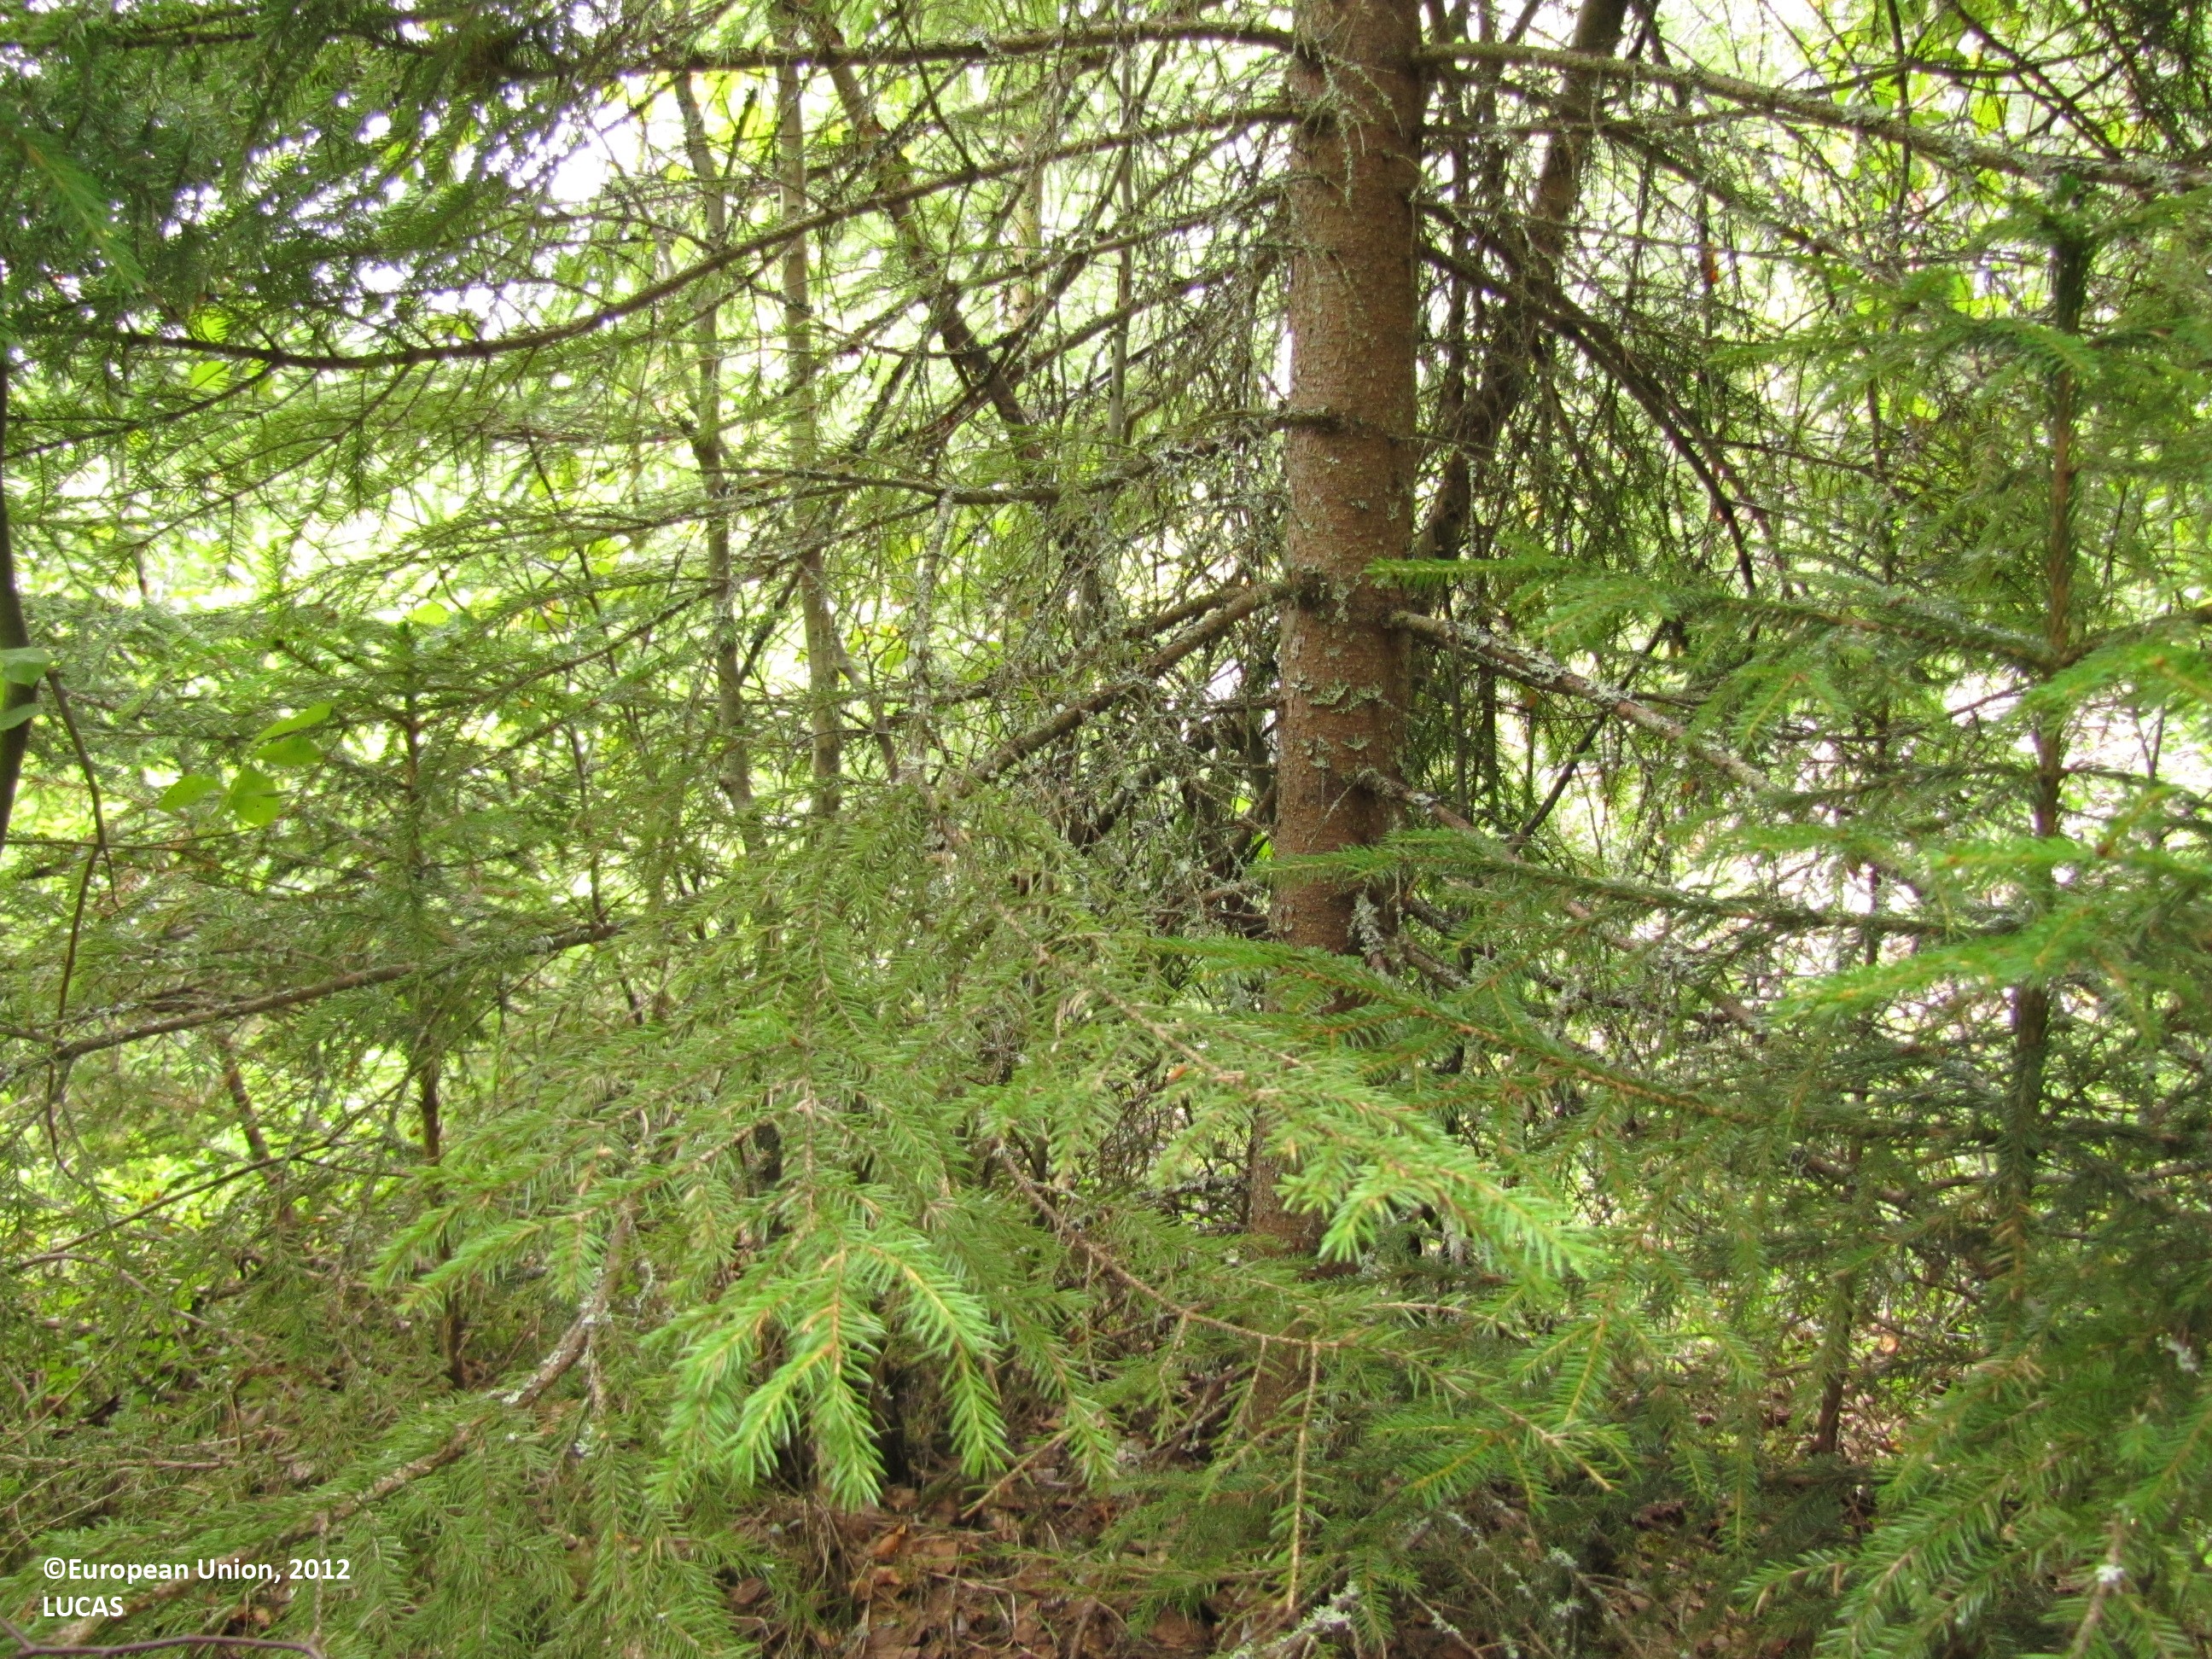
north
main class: Woodland
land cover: Pine dominated mixed woodland
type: boreal forest
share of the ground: 50 - 75 %
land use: Forestry
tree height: > 5 m
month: August
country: FI
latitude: 61.8978
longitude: 23.2213
